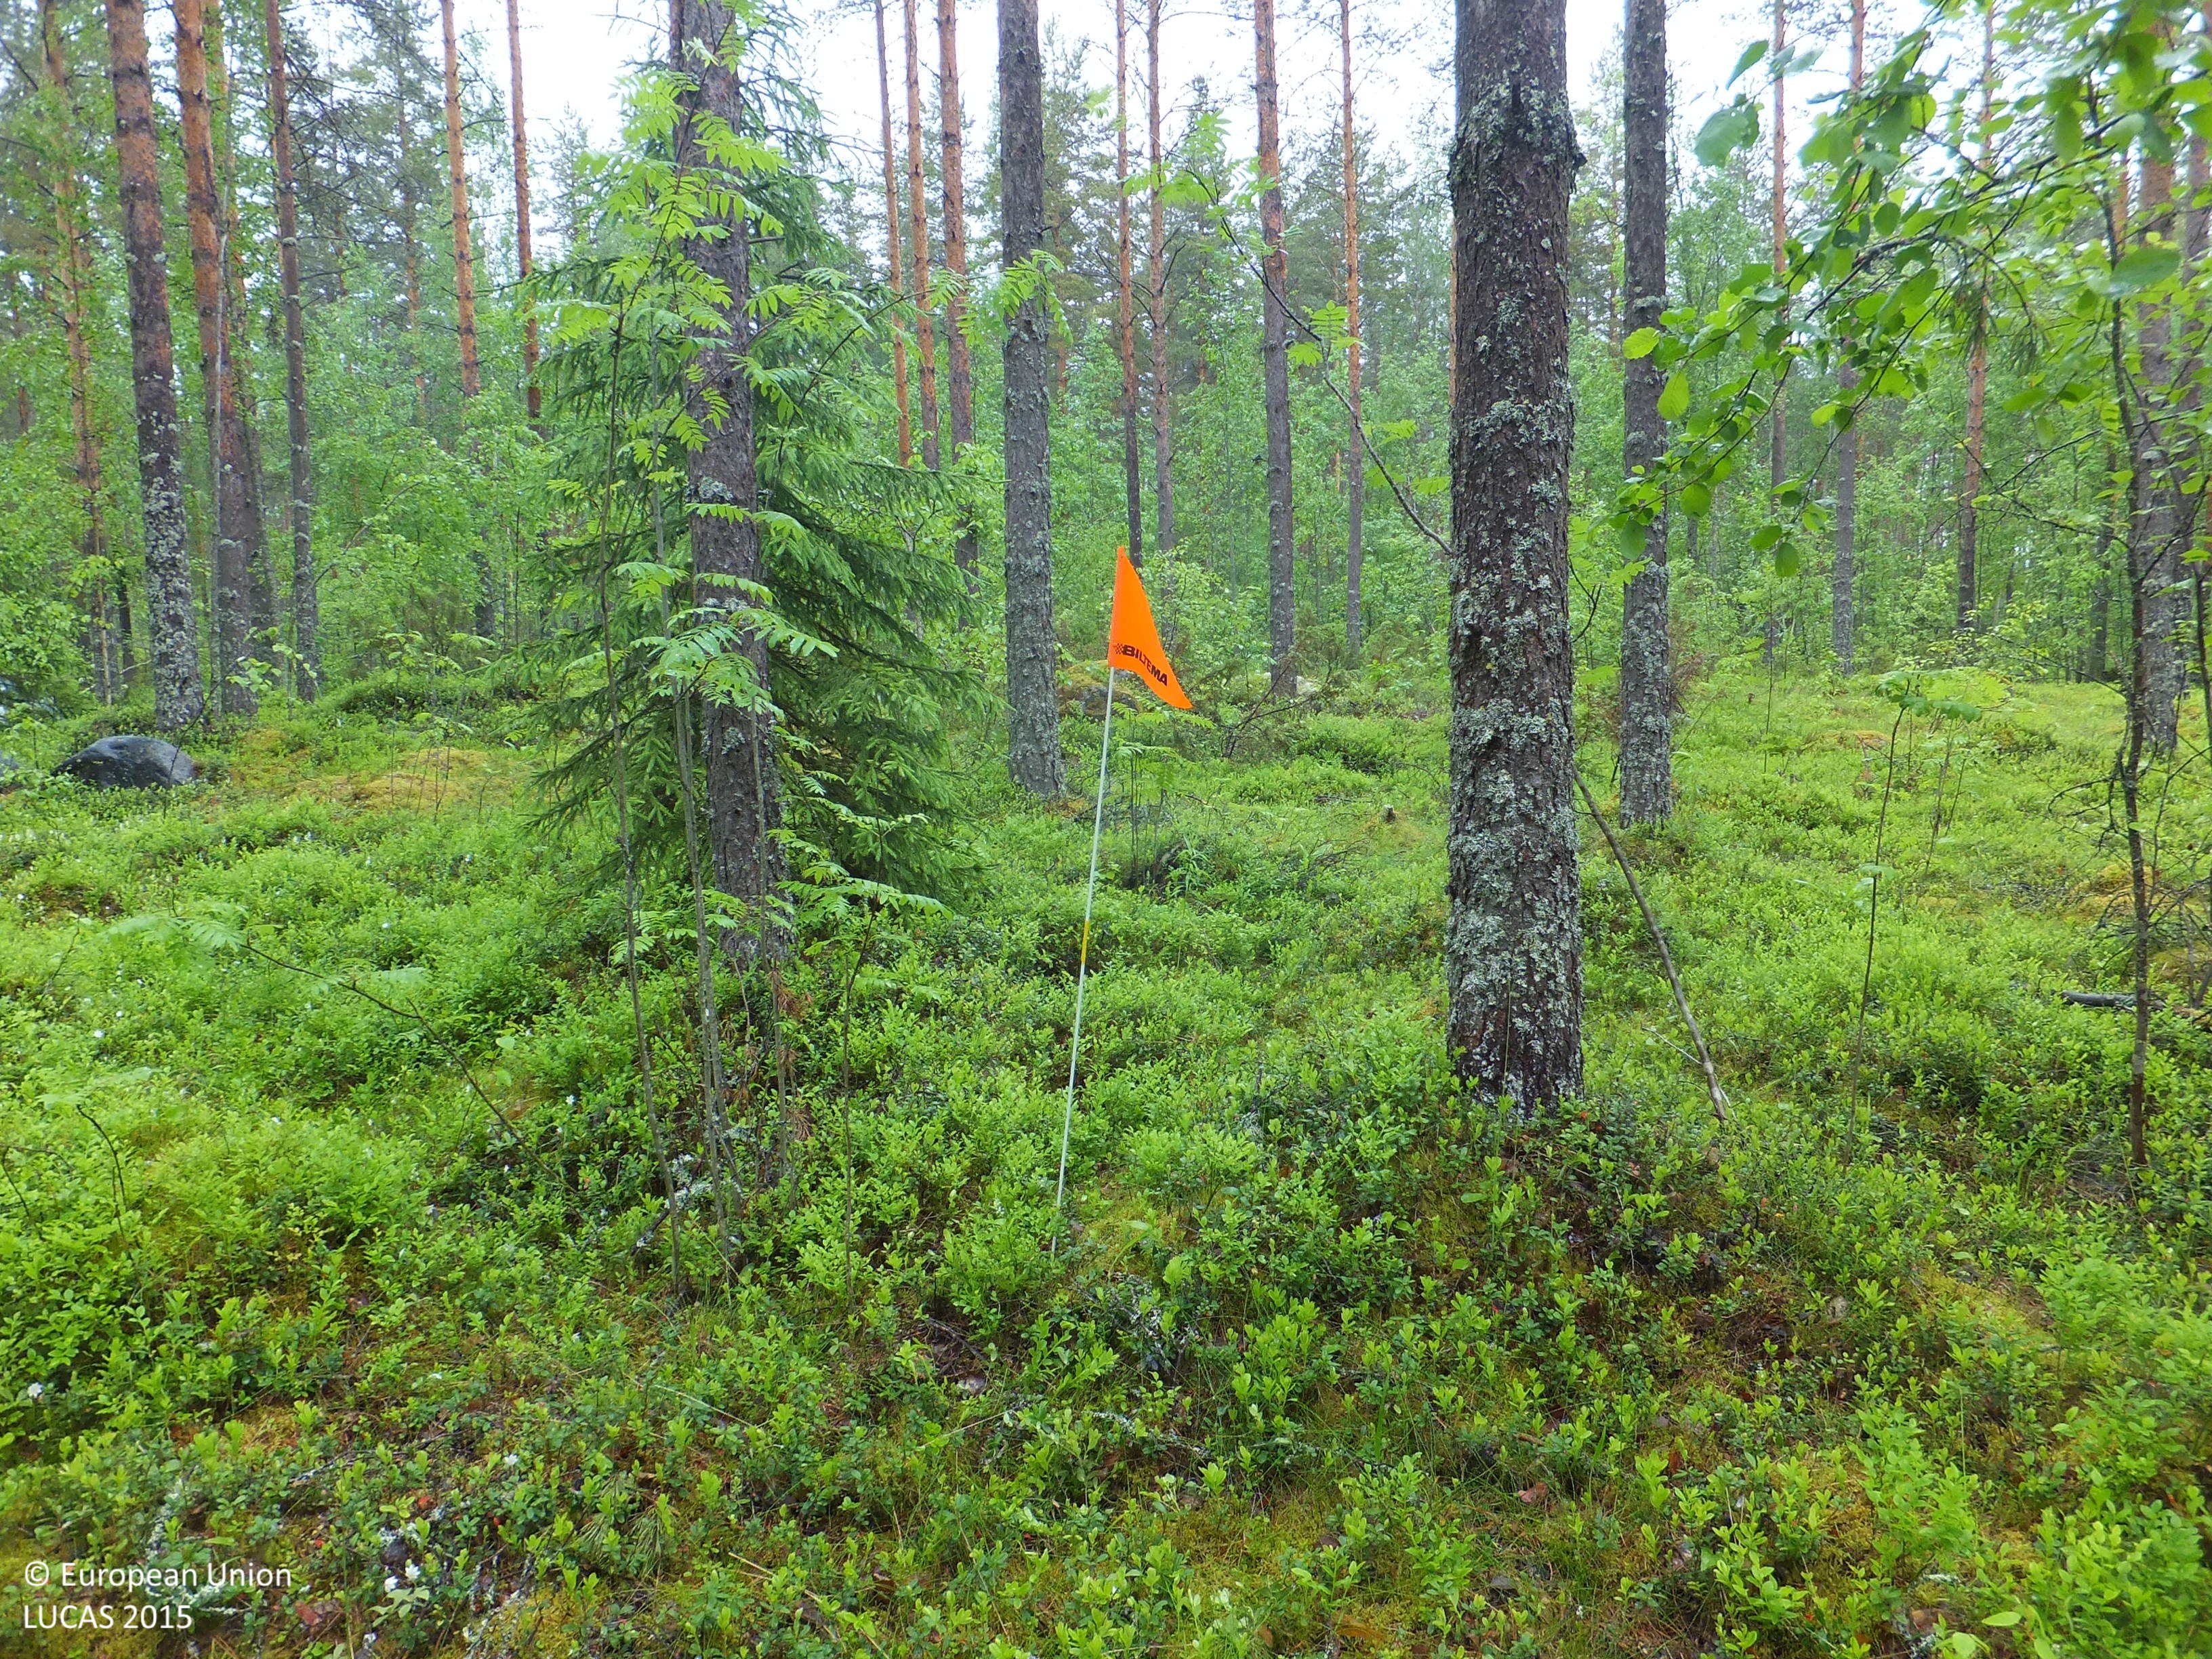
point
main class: Woodland
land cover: Pine dominated coniferous woodland
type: boreal forest
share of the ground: > 75 %
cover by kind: coniferous forest trees 80 %, shrubs 10 %, broadleaved forest trees 5 %, lichens and mosses 5 %
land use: Forestry
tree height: > 5 m
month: June
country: FI
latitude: 63.3296
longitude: 24.8050
